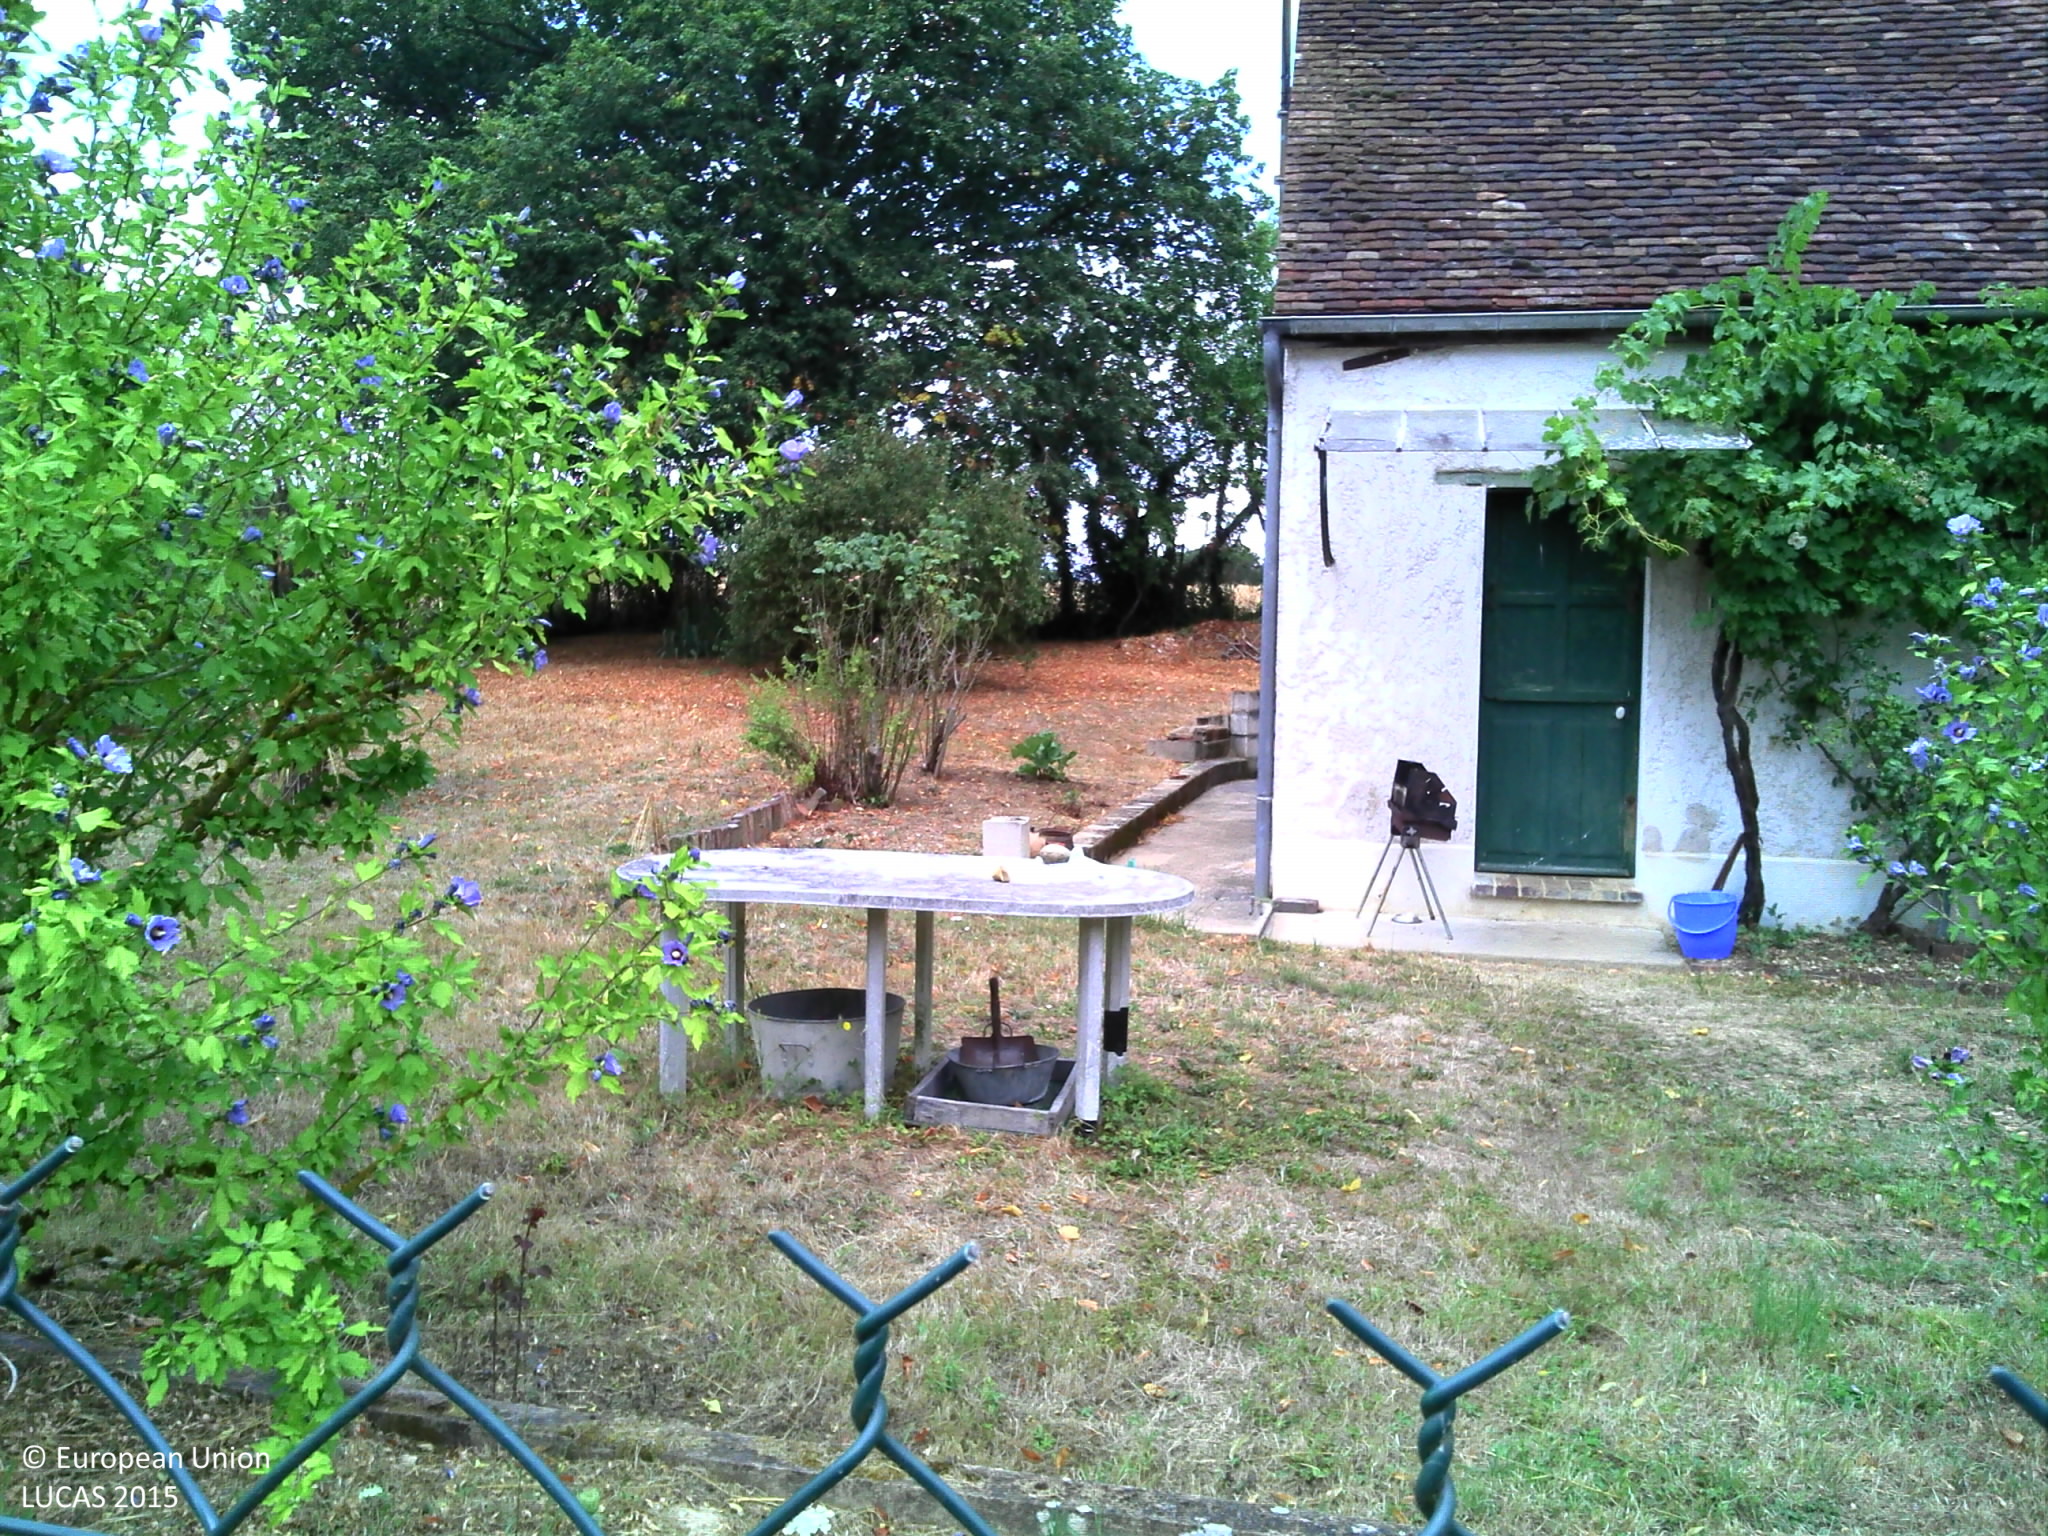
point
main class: Grassland
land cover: Grassland with sparse tree/shrub cover
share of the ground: > 75 %
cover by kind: herbaceous plants 90 %, broadleaved forest trees 5 %, shrubs 5 %
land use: Amenities, museums, leisure
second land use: Residential
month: July
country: FR
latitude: 48.0801
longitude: 3.4036
